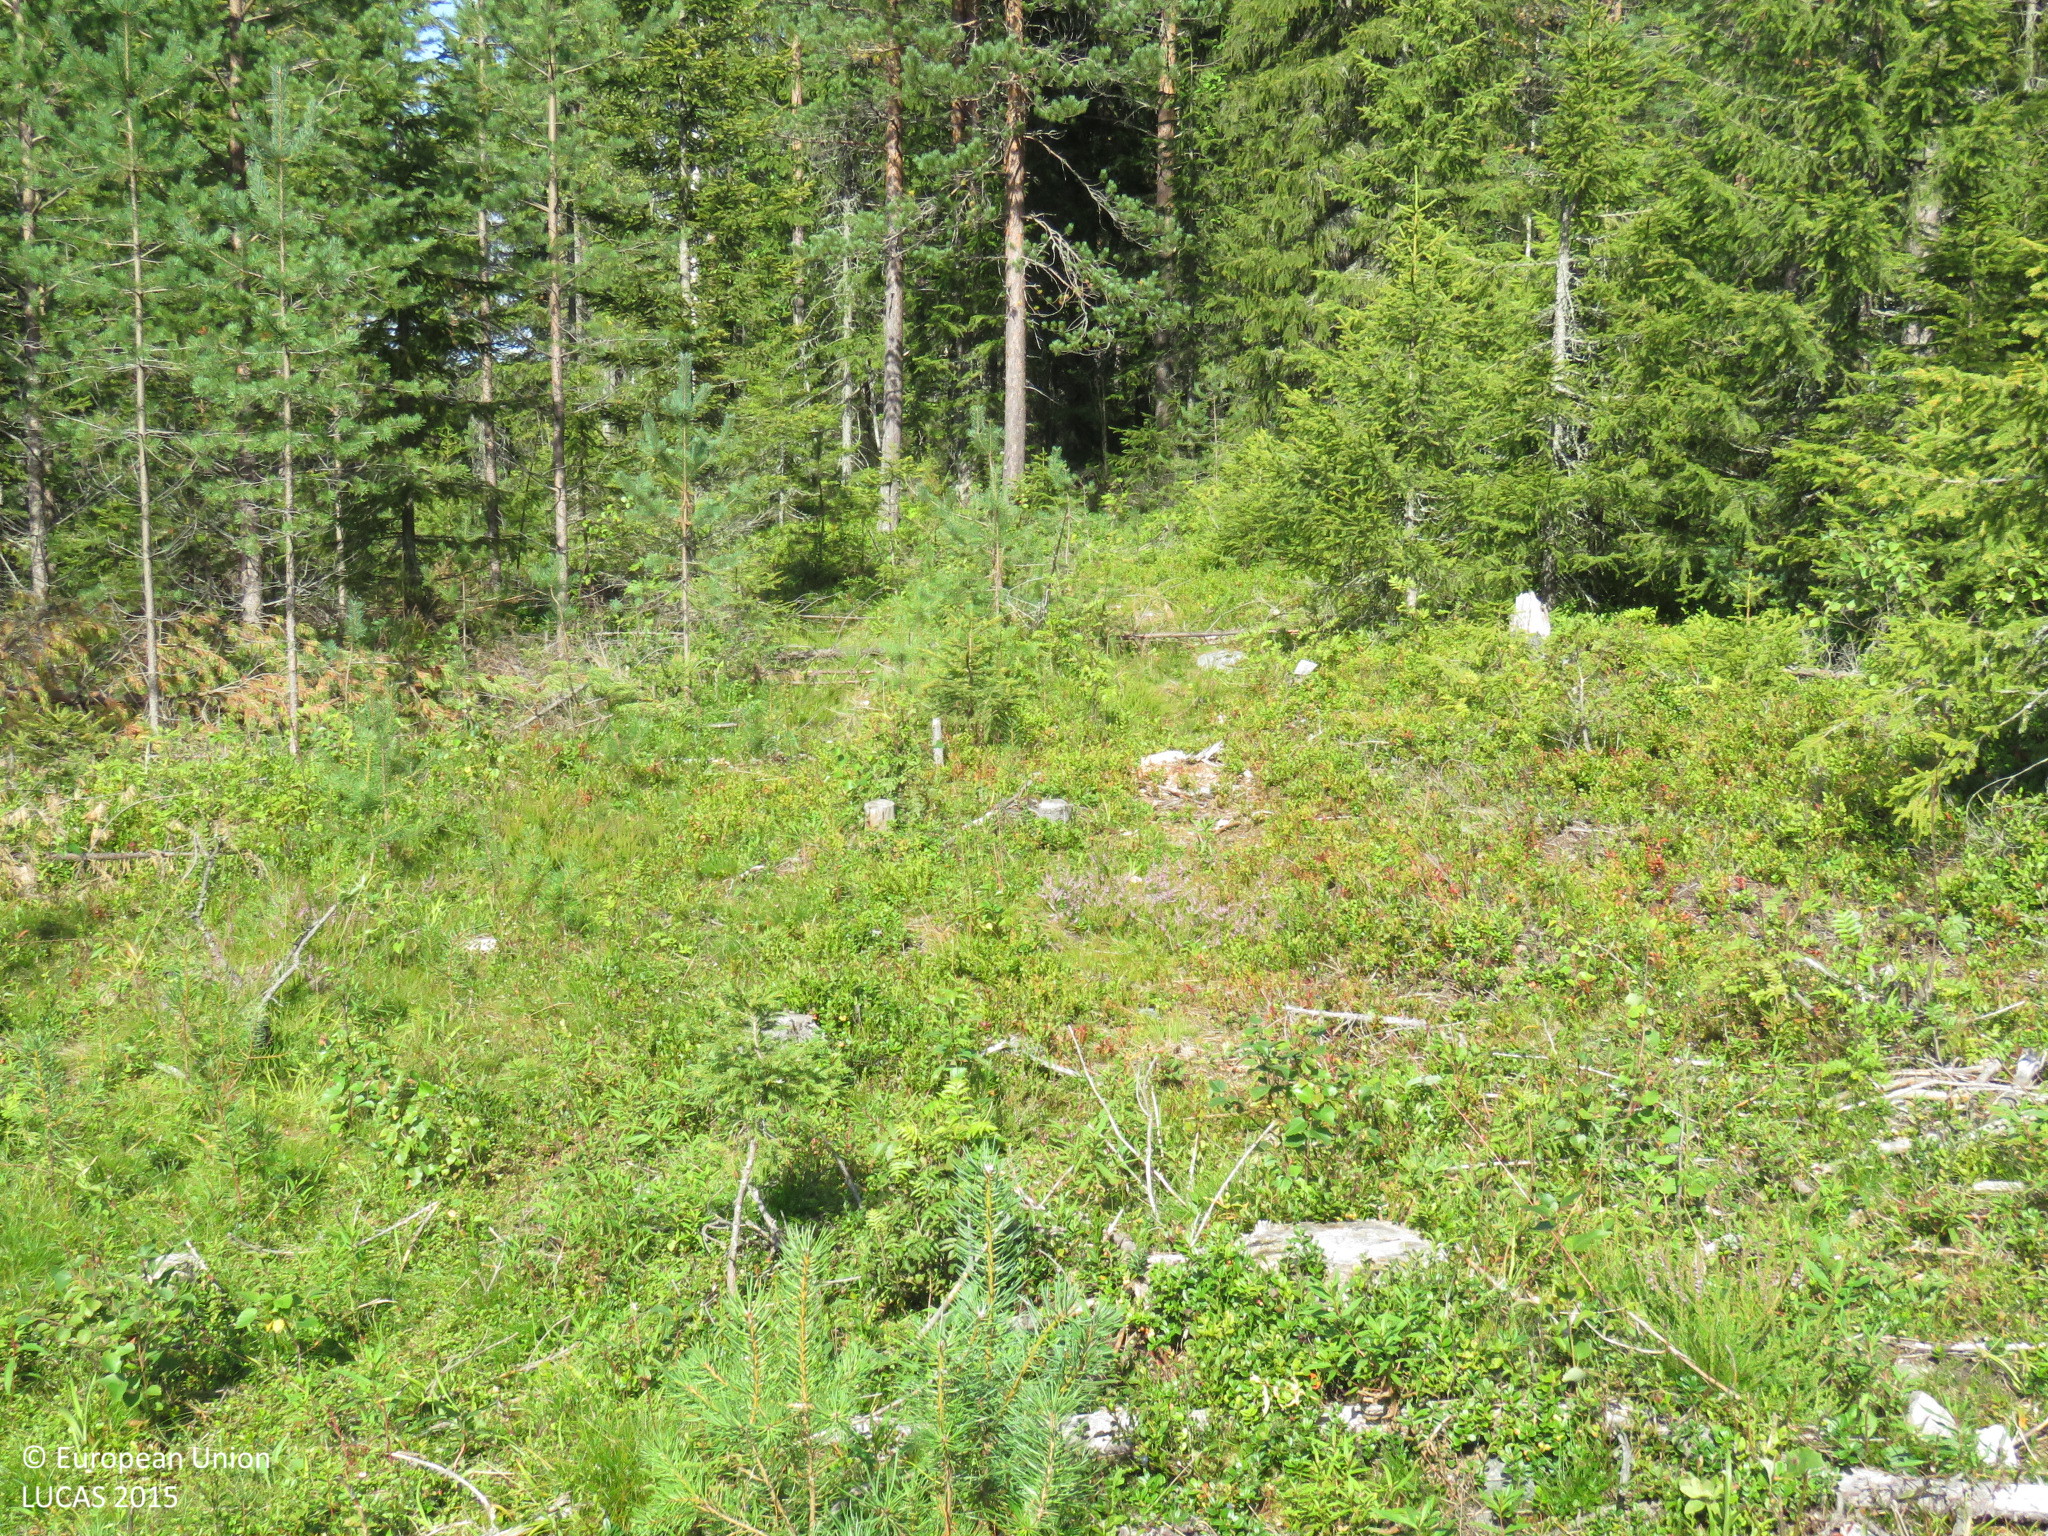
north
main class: Woodland
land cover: Other mixed woodland
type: boreal forest
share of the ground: 25 - 50 %
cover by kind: shrubs 40 %, coniferous forest trees 20 %, herbaceous plants 20 %, broadleaved forest trees 10 %, unconsolidated bare surface 10 %
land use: Forestry
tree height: < 5 m
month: August
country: FI
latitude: 65.2245
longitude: 26.0259
